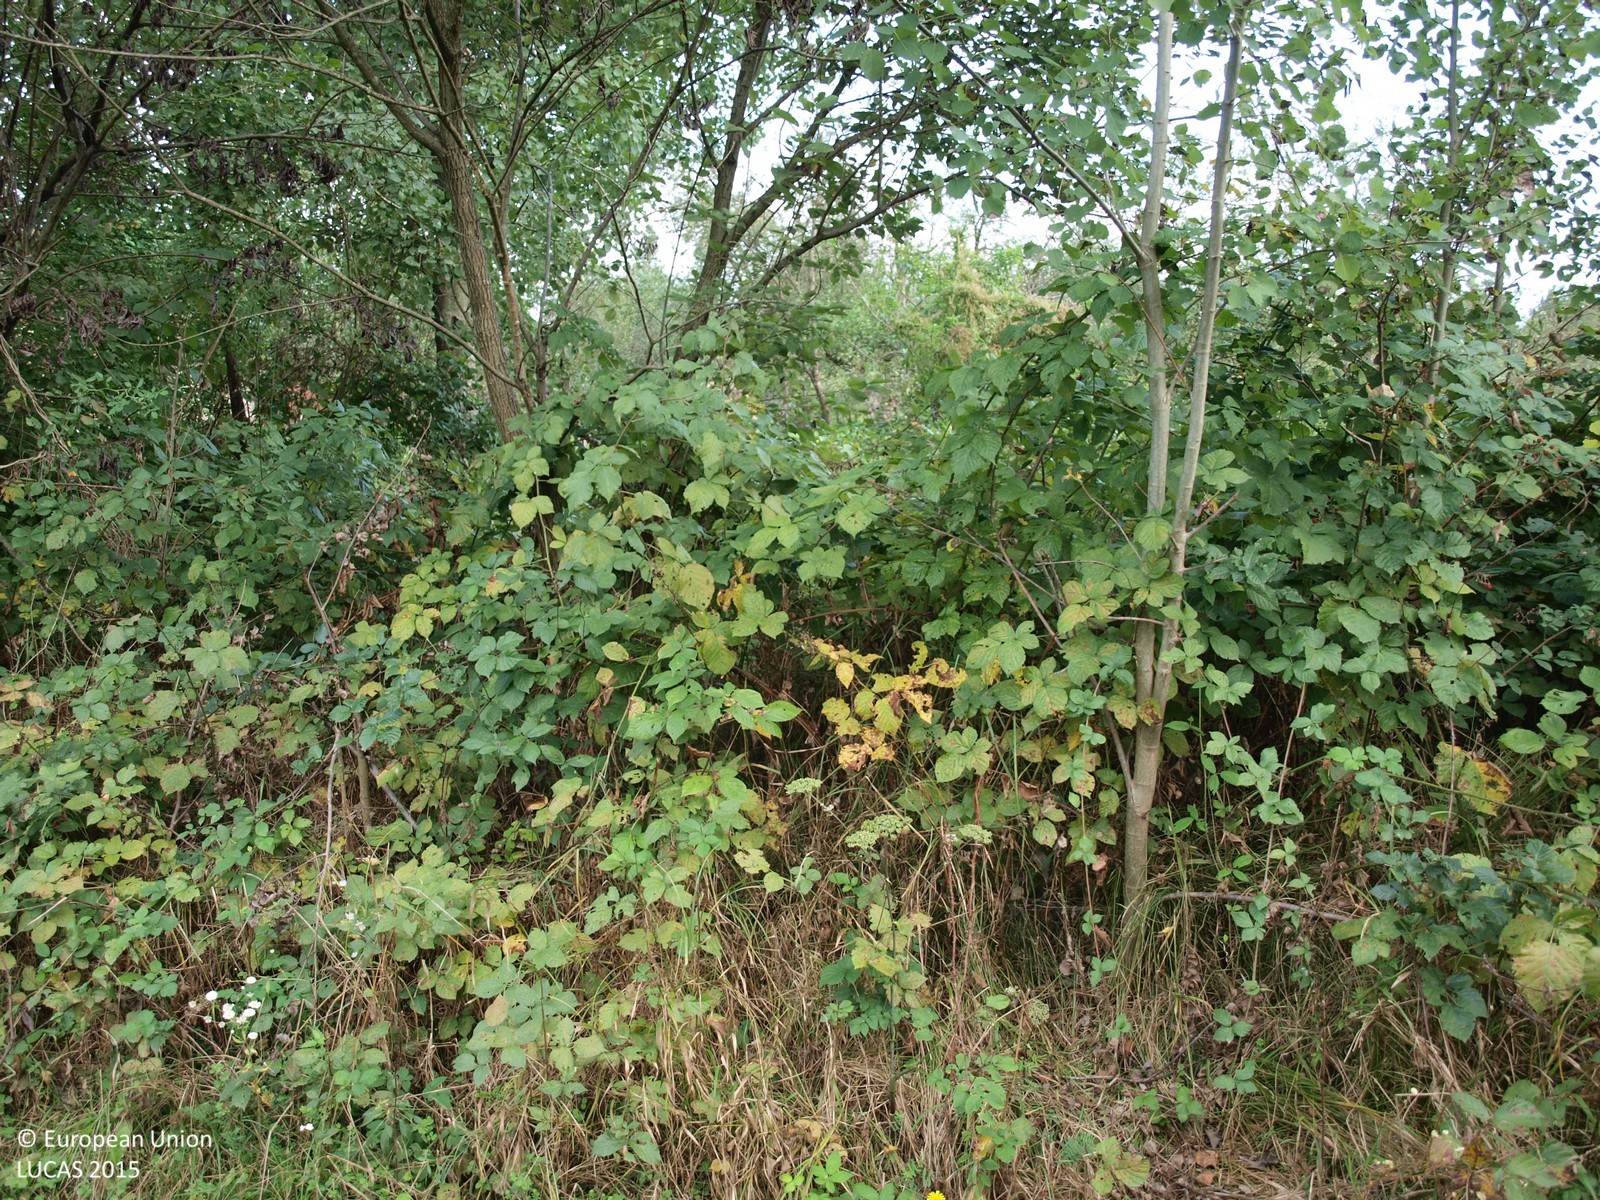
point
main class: Shrubland
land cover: Shrubland with sparse tree cover
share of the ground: > 75 %
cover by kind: shrubs 95 %, broadleaved forest trees 5 %
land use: Semi-natural and natural areas not in use
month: October
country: HR
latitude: 45.4532
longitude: 16.1222
